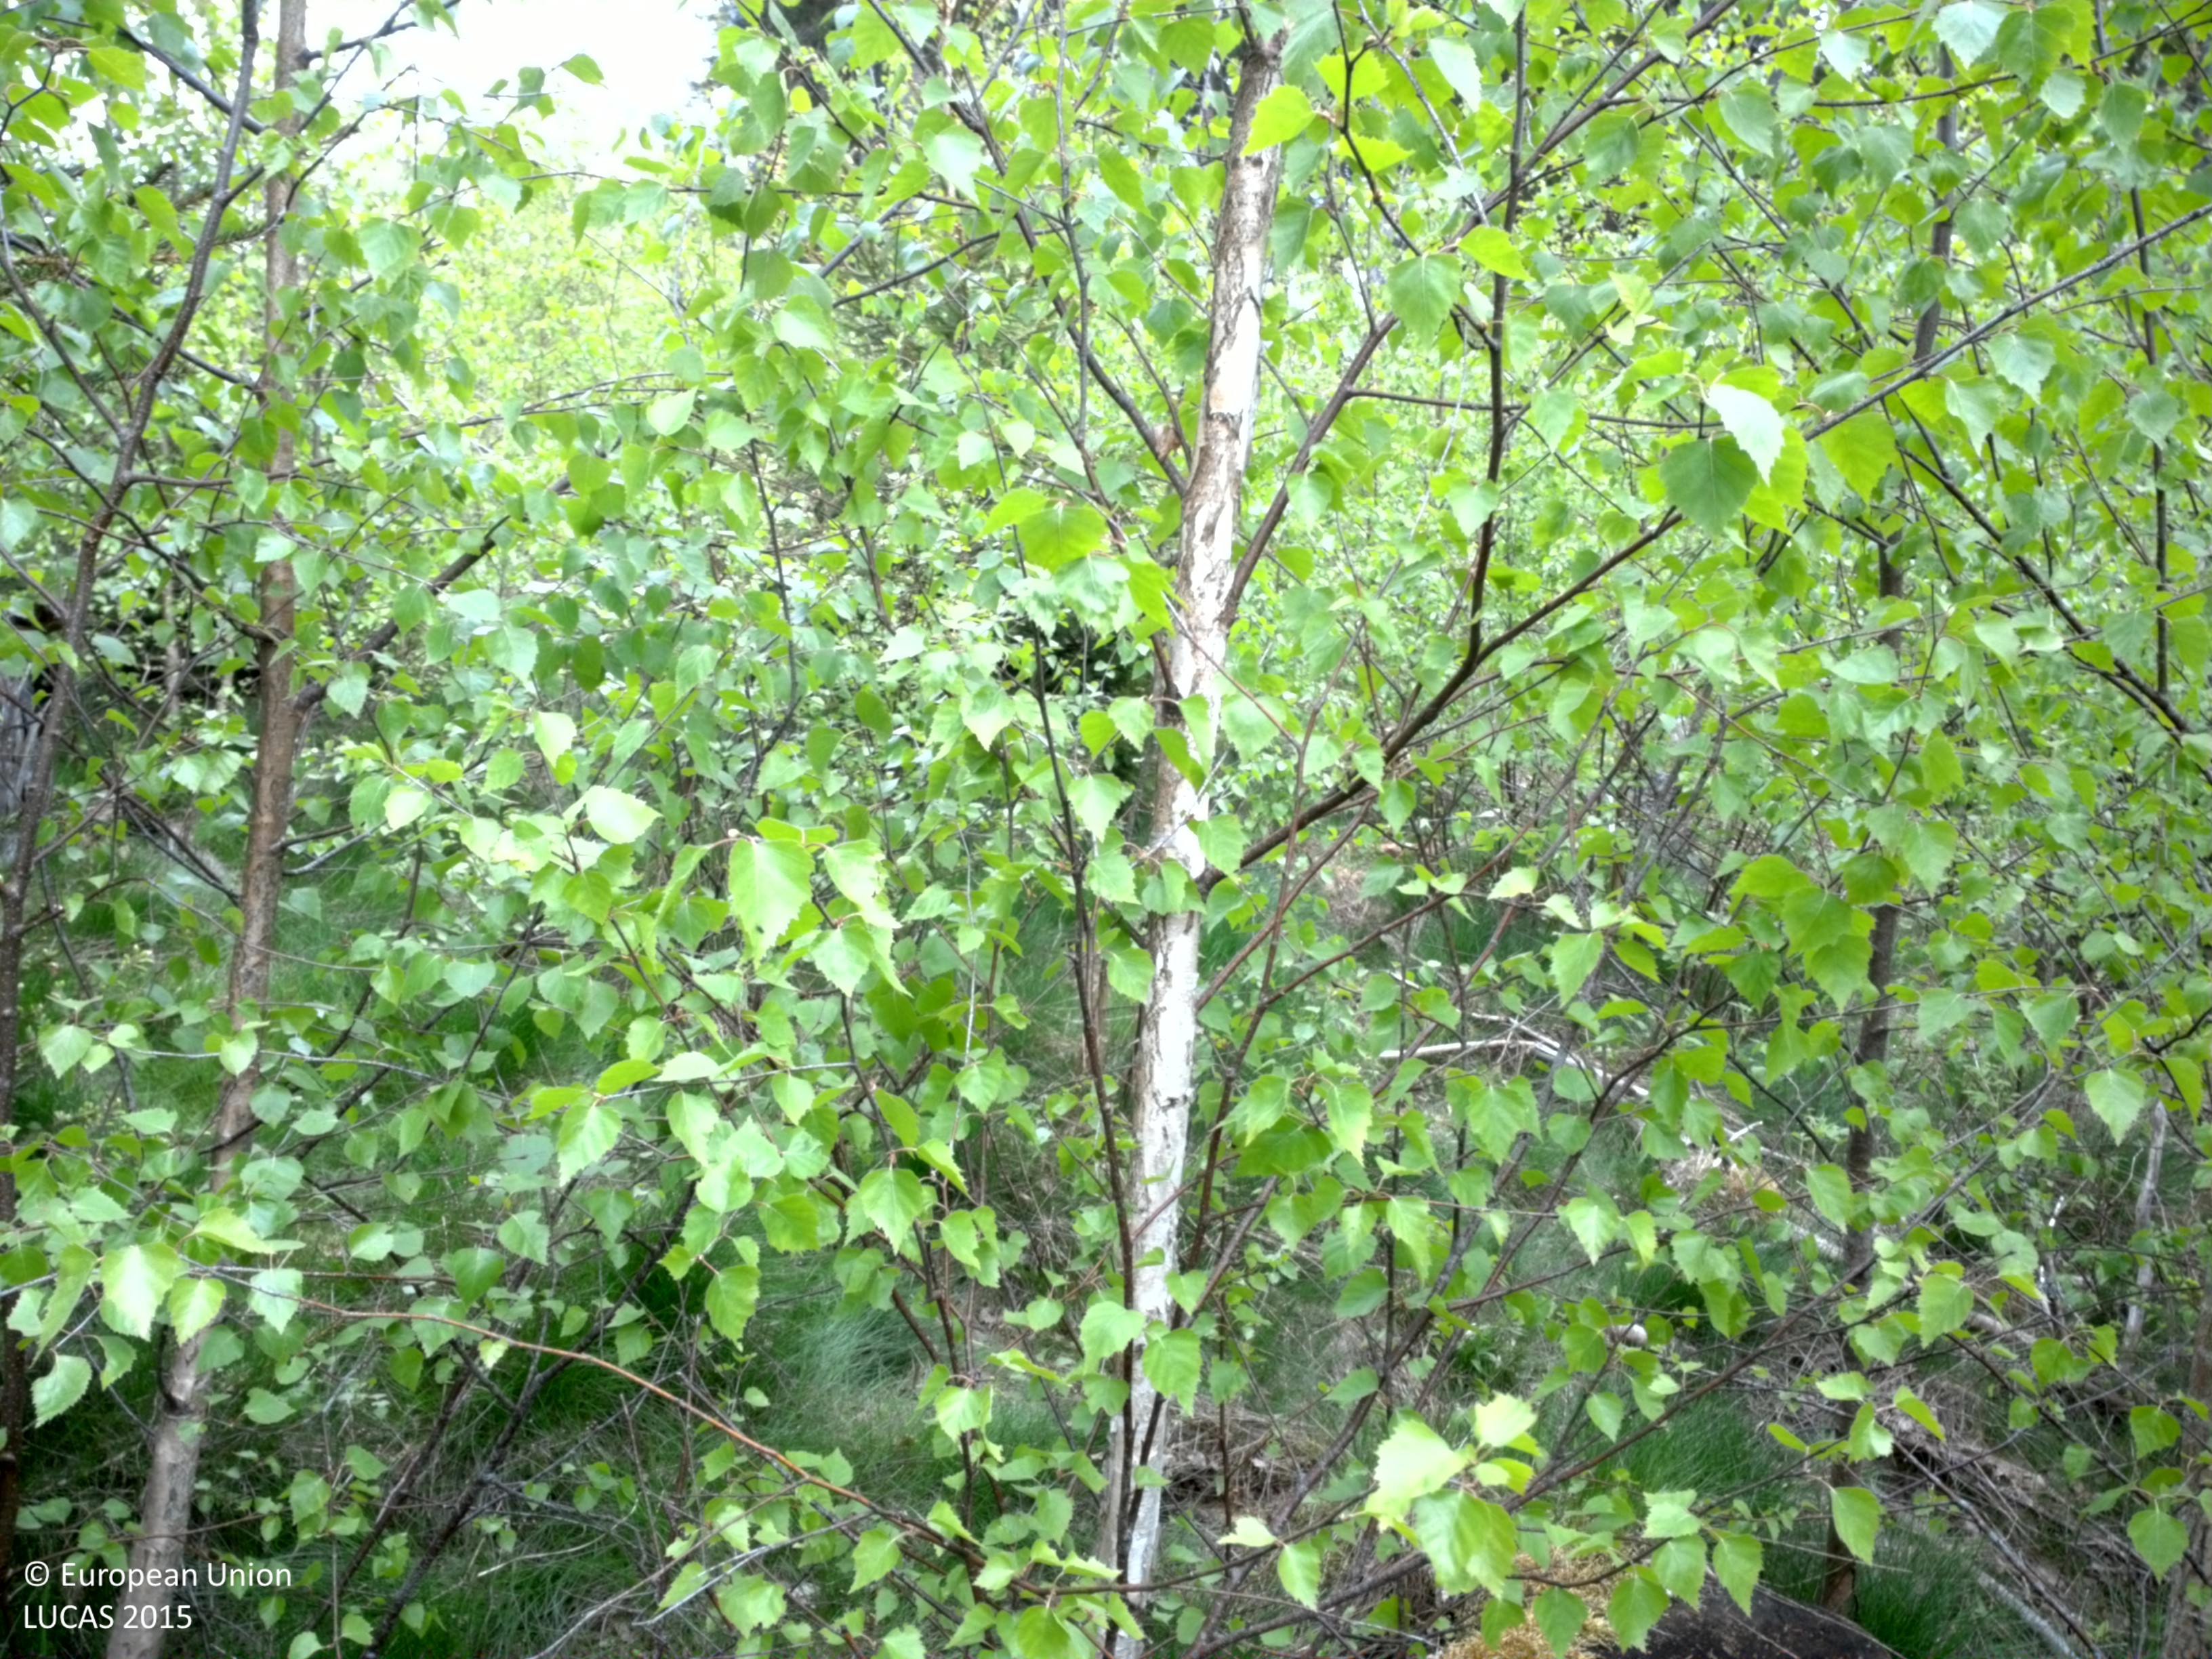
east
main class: Woodland
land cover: Broadleaved woodland
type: boreal forest
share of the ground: > 75 %
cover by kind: broadleaved forest trees 85 %, herbaceous plants 10 %, coniferous forest trees 5 %
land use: Forestry
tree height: < 5 m
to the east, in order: Broadleaved woodland; Spruce dominated coniferous woodland; Paved roads, cycling and walking lanes; Fences; Grassland without tree/shrub cover; Dry stone walls; Grassland with sparse tree/shrub cover; Grassland without tree/shrub cover; Spruce dominated coniferous woodland; Fences; Spruce dominated coniferous woodland; Grassland with sparse tree/shrub cover
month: May
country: SE
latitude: 56.7392
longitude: 15.4424
